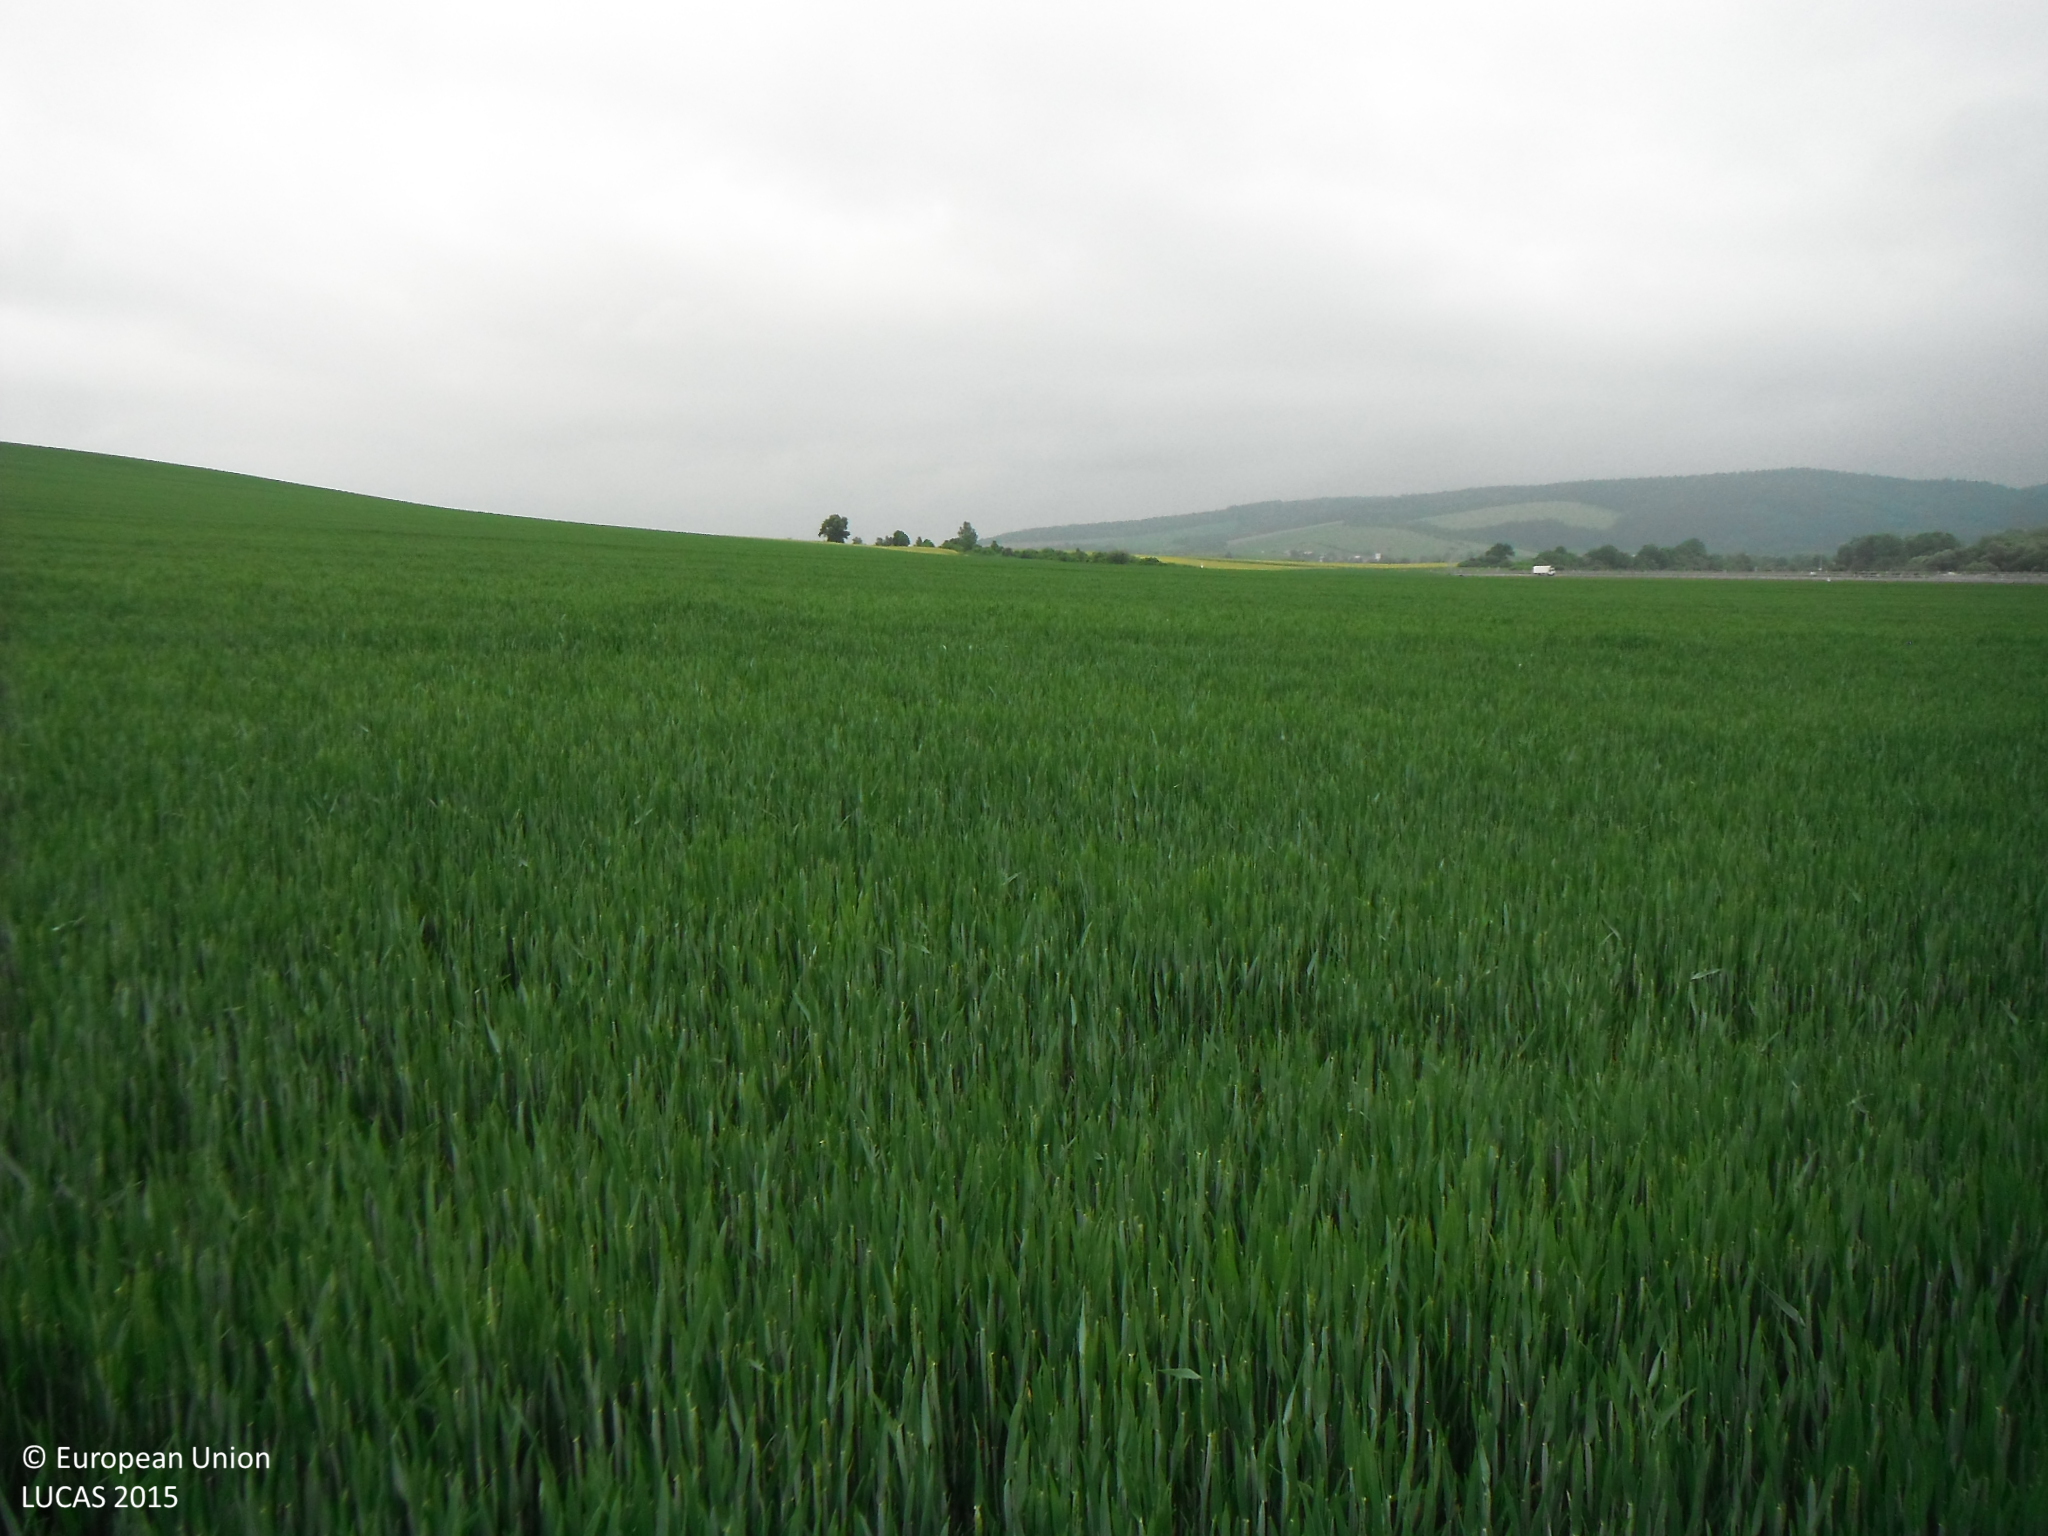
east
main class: Cropland
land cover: Common wheat
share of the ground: > 75 %
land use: Agriculture (excluding fallow land and kitchen gardens)
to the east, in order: Common wheat
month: May
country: SK
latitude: 49.0047
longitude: 21.1024
